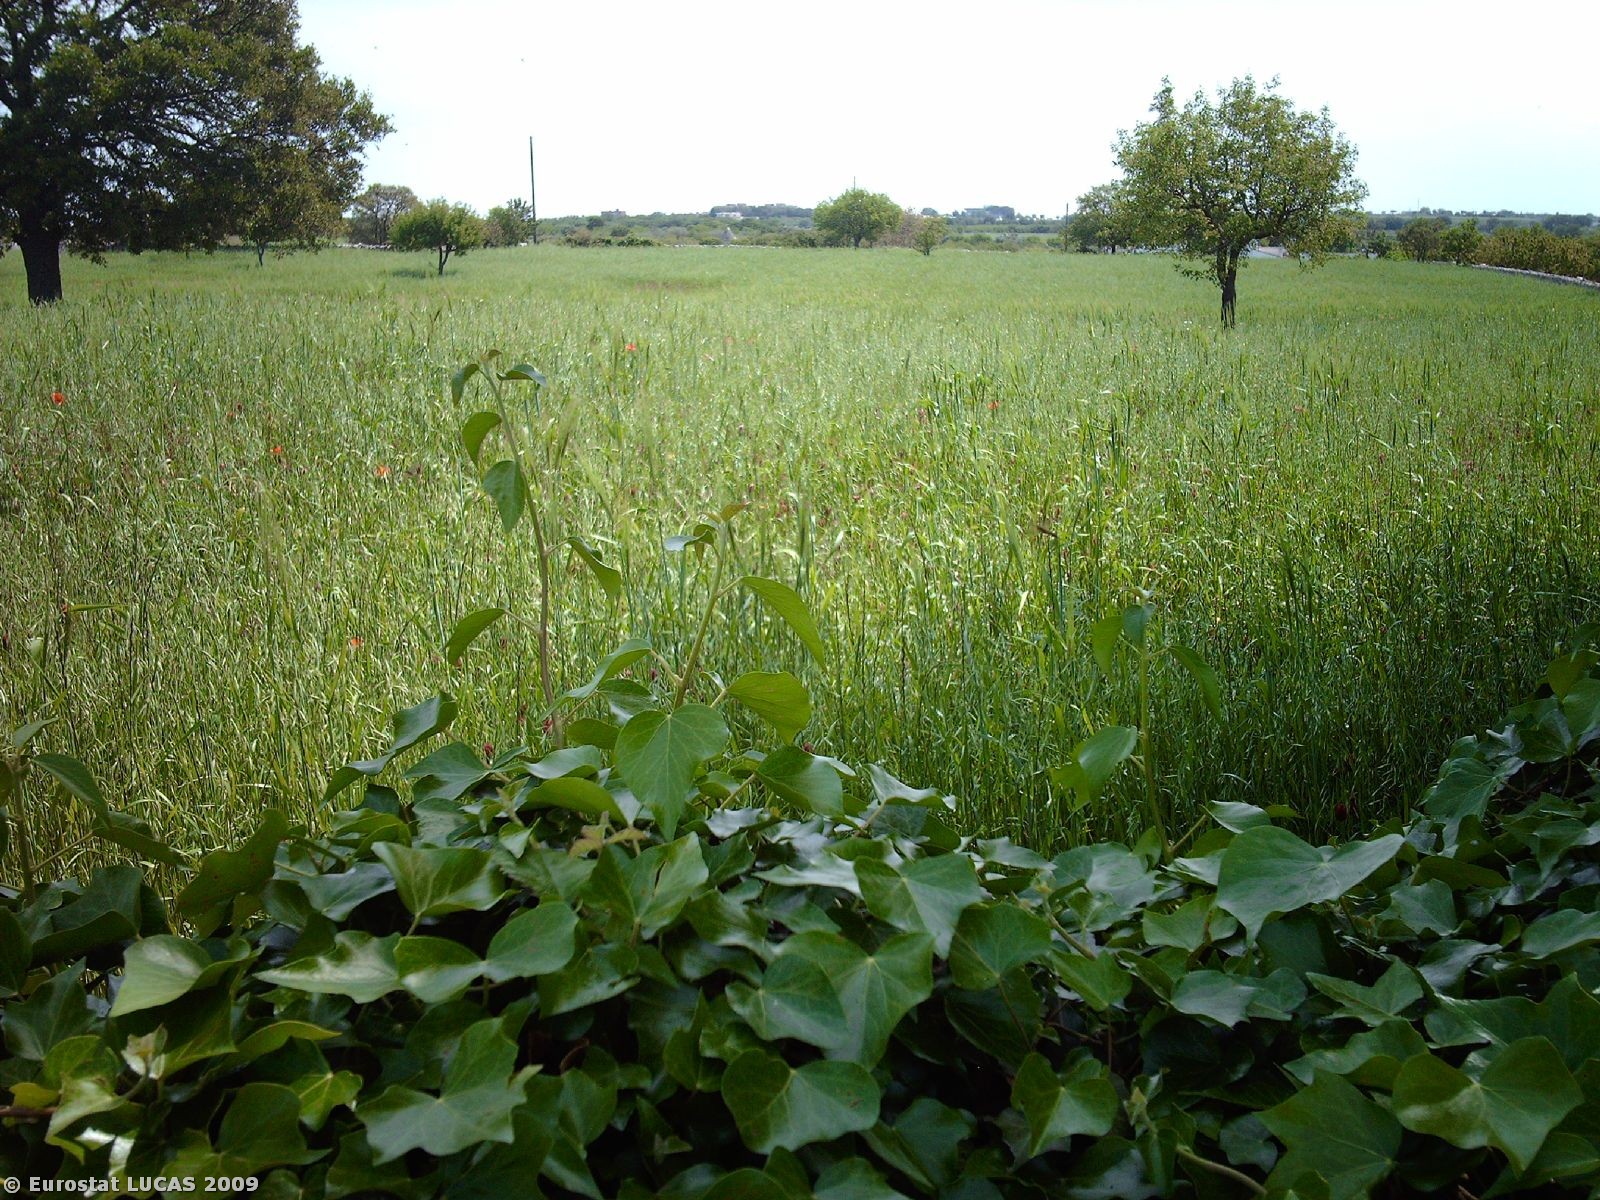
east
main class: Cropland
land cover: Mixed cereals for fodder
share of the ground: > 75 %
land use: Agriculture (excluding fallow land and kitchen gardens)
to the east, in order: Mixed cereals for fodder; Dry stone walls; Mixed cereals for fodder; Dry stone walls; Mixed cereals for fodder
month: May
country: IT
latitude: 40.8659
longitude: 17.0611
